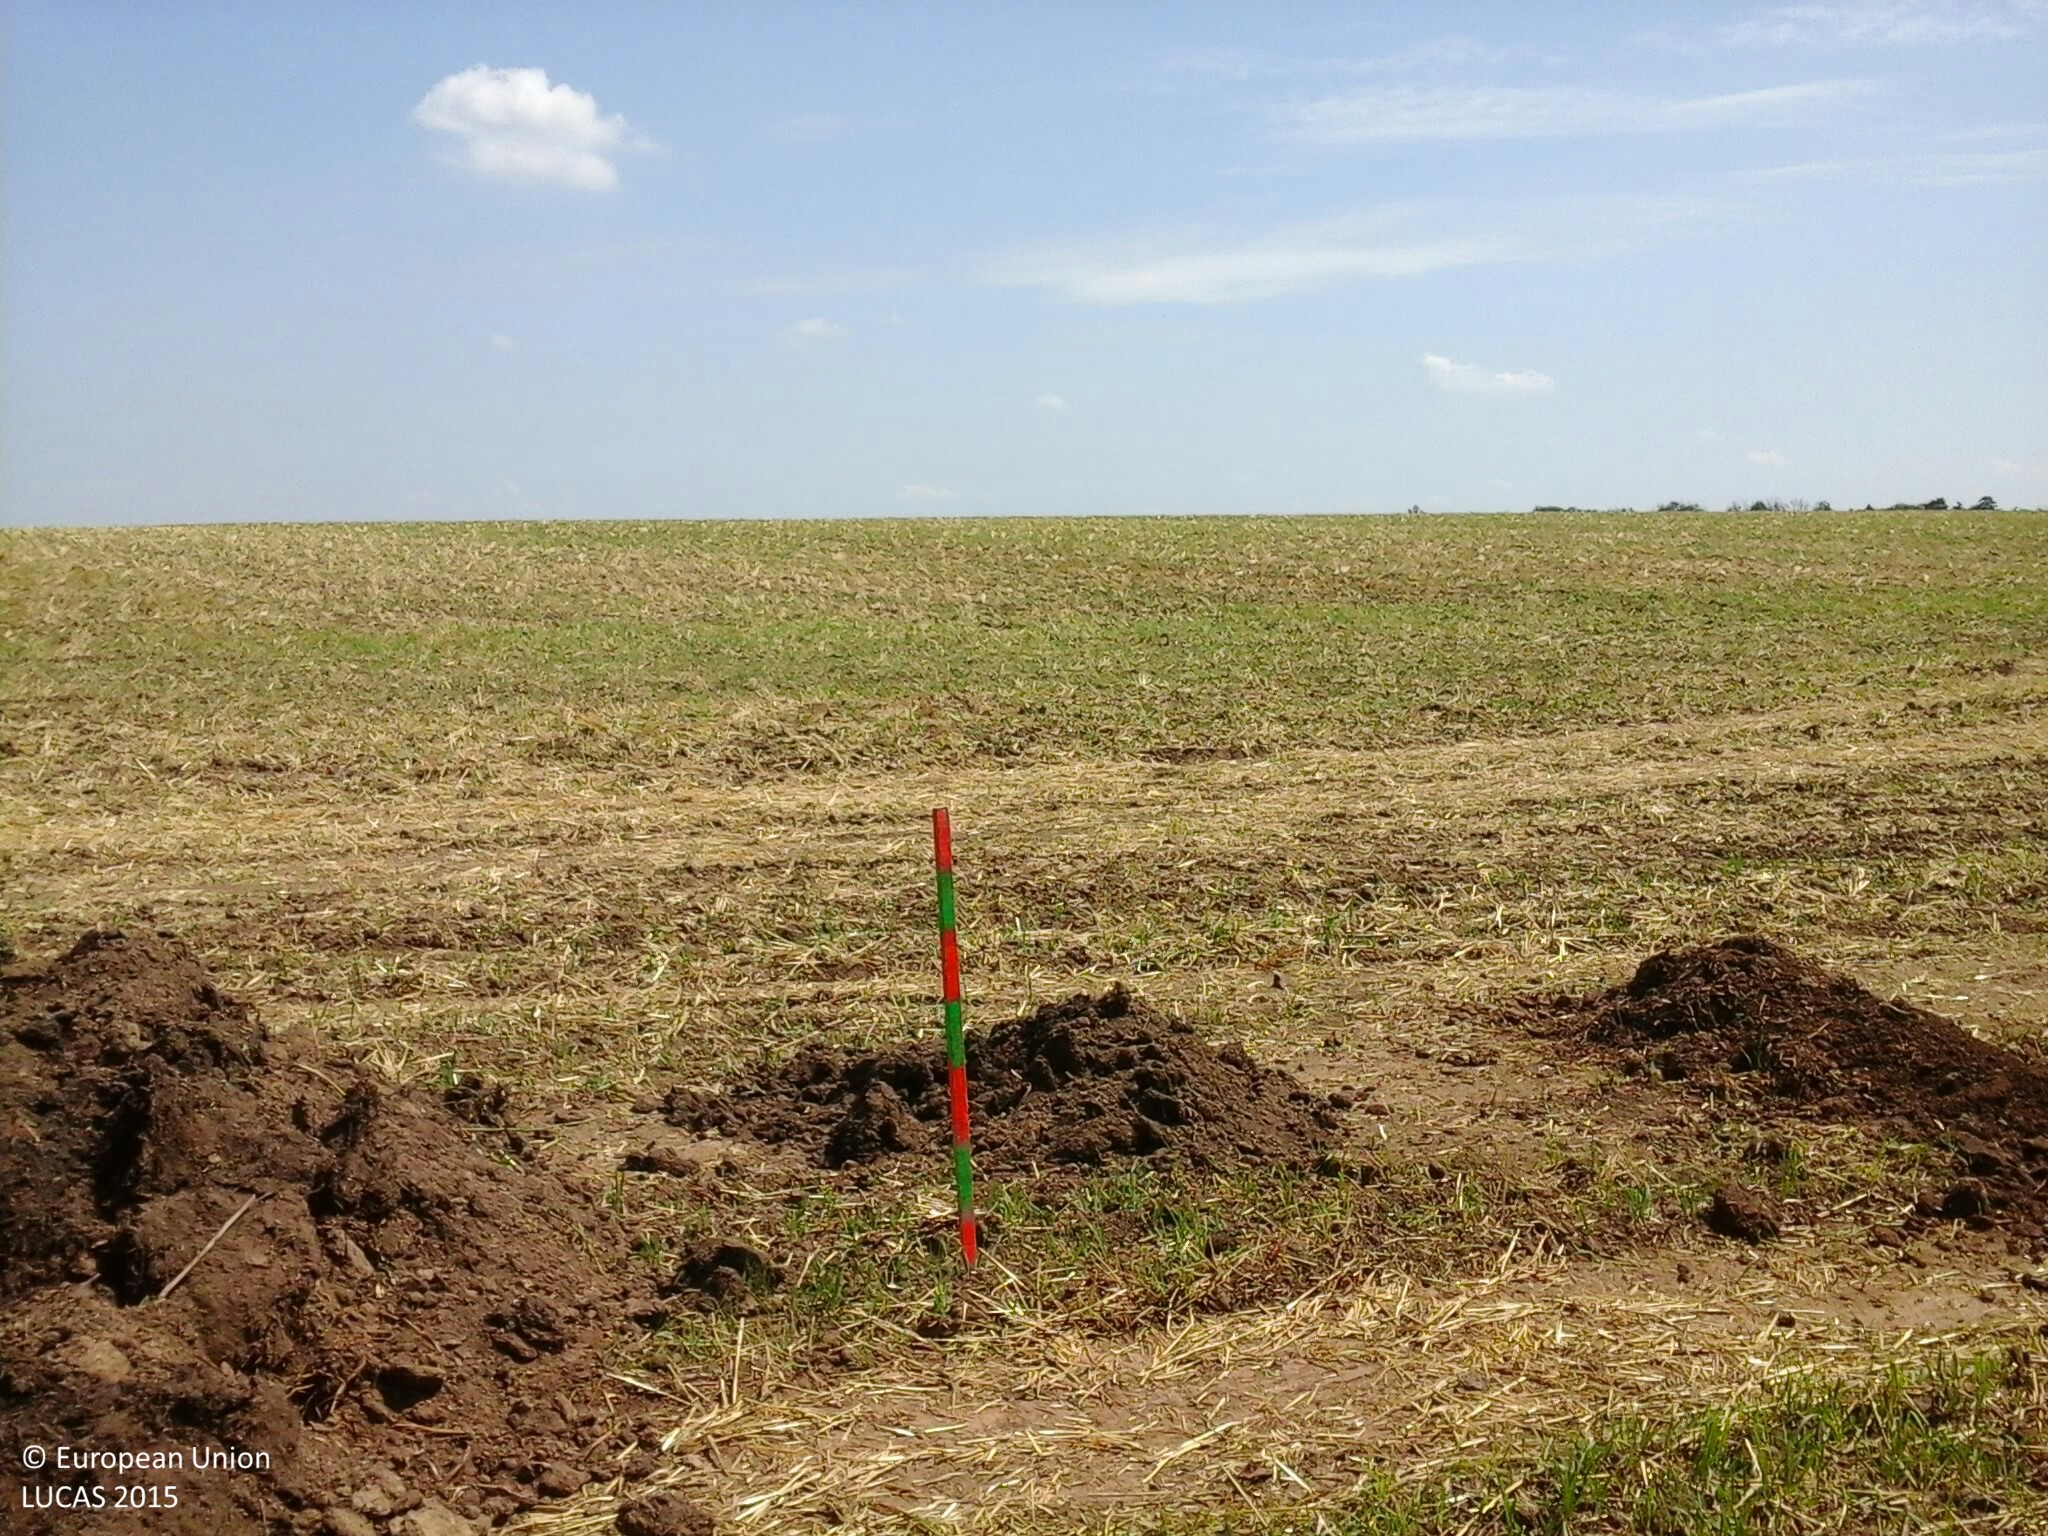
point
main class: Cropland
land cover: Common wheat
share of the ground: > 75 %
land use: Agriculture (excluding fallow land and kitchen gardens)
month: August
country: HU
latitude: 46.8617
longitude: 18.0499
